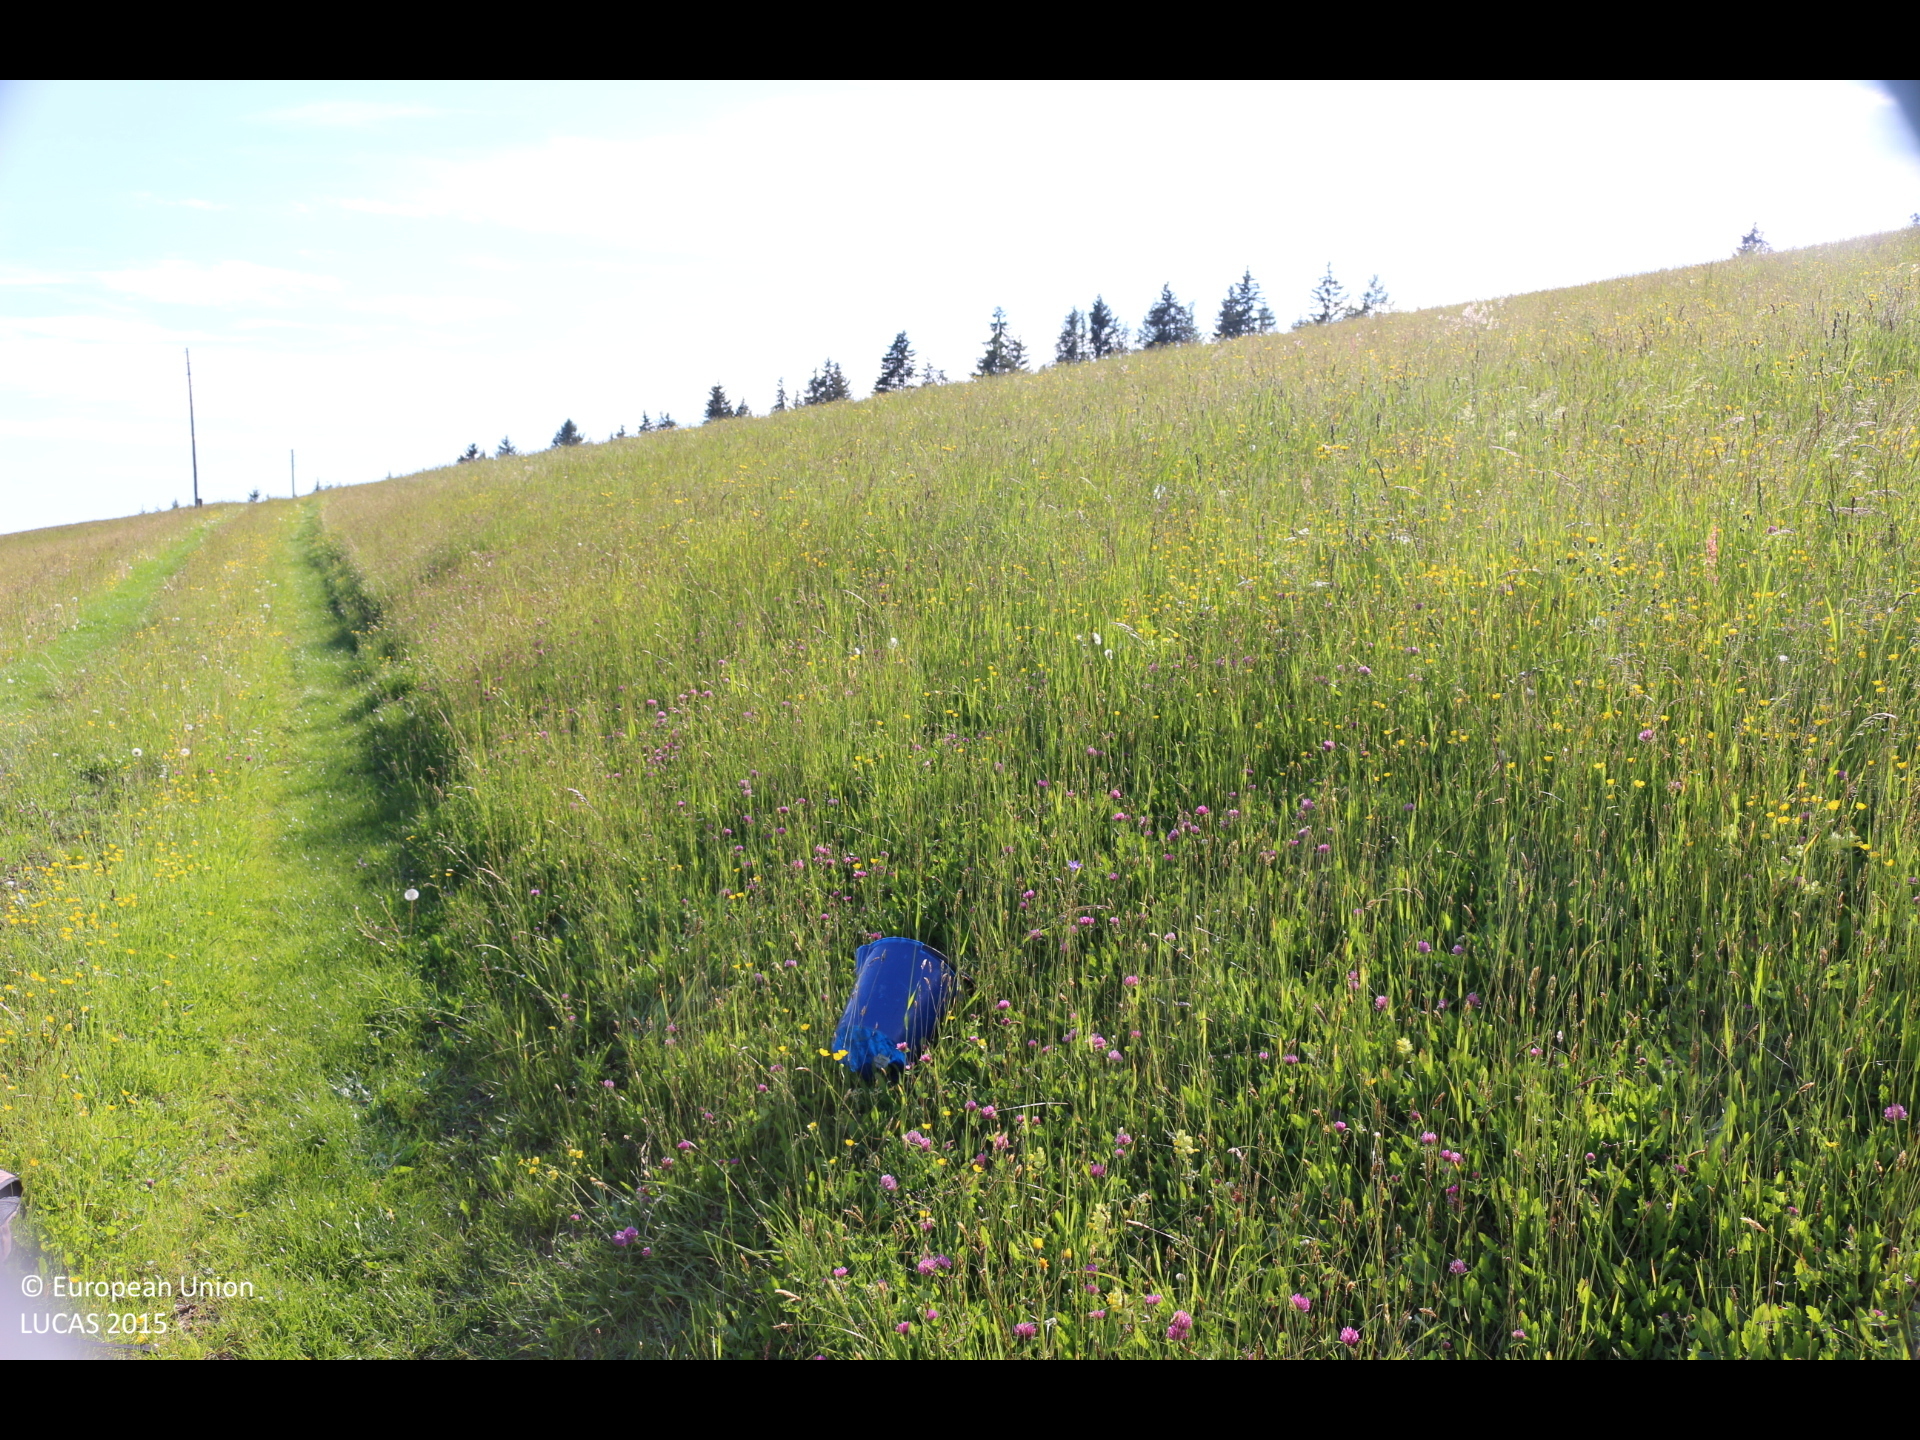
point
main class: Grassland
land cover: Grassland without tree/shrub cover
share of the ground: > 75 %
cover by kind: herbaceous plants 100 %
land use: Agriculture (excluding fallow land and kitchen gardens)
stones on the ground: < 10 %
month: May
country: AT
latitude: 46.7576
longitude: 14.5933
